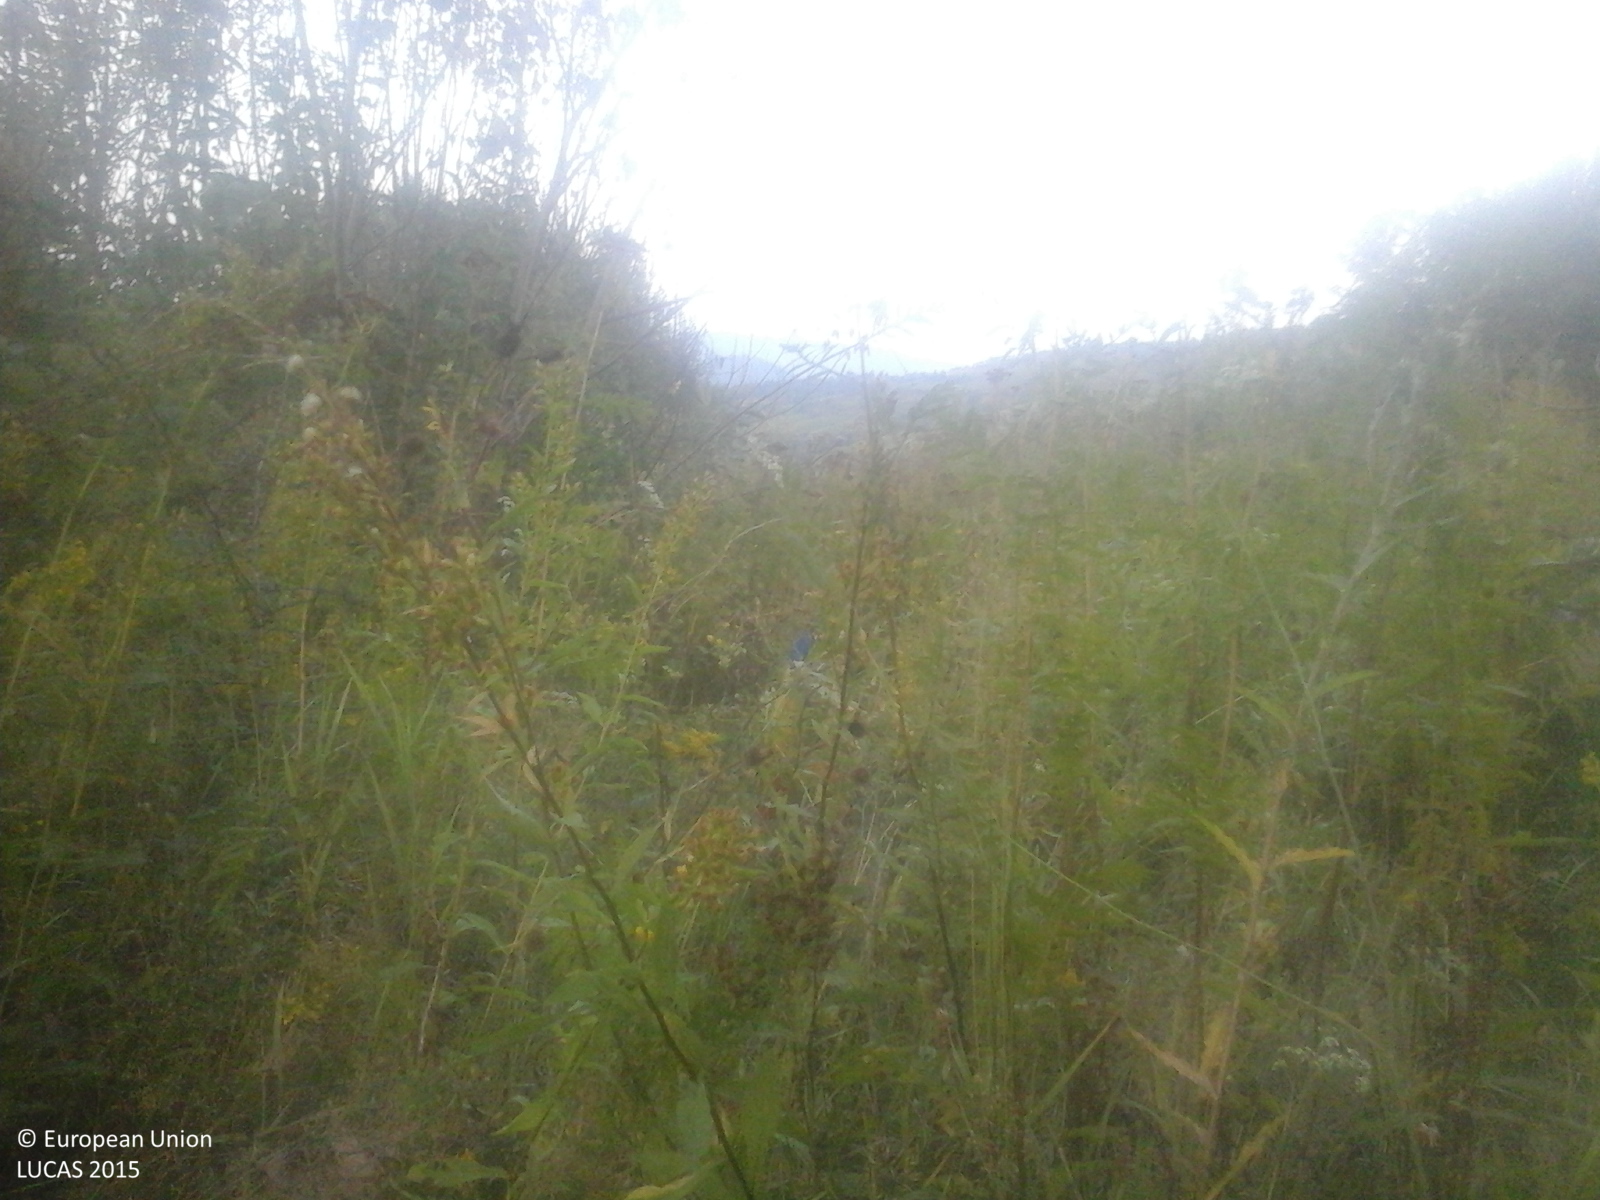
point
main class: Grassland
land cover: Grassland with sparse tree/shrub cover
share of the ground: > 75 %
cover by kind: herbaceous plants 85 %, shrubs 10 %, broadleaved forest trees 5 %
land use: Agriculture (excluding fallow land and kitchen gardens)
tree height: < 5 m
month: September
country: RO
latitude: 47.6547
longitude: 24.2693
